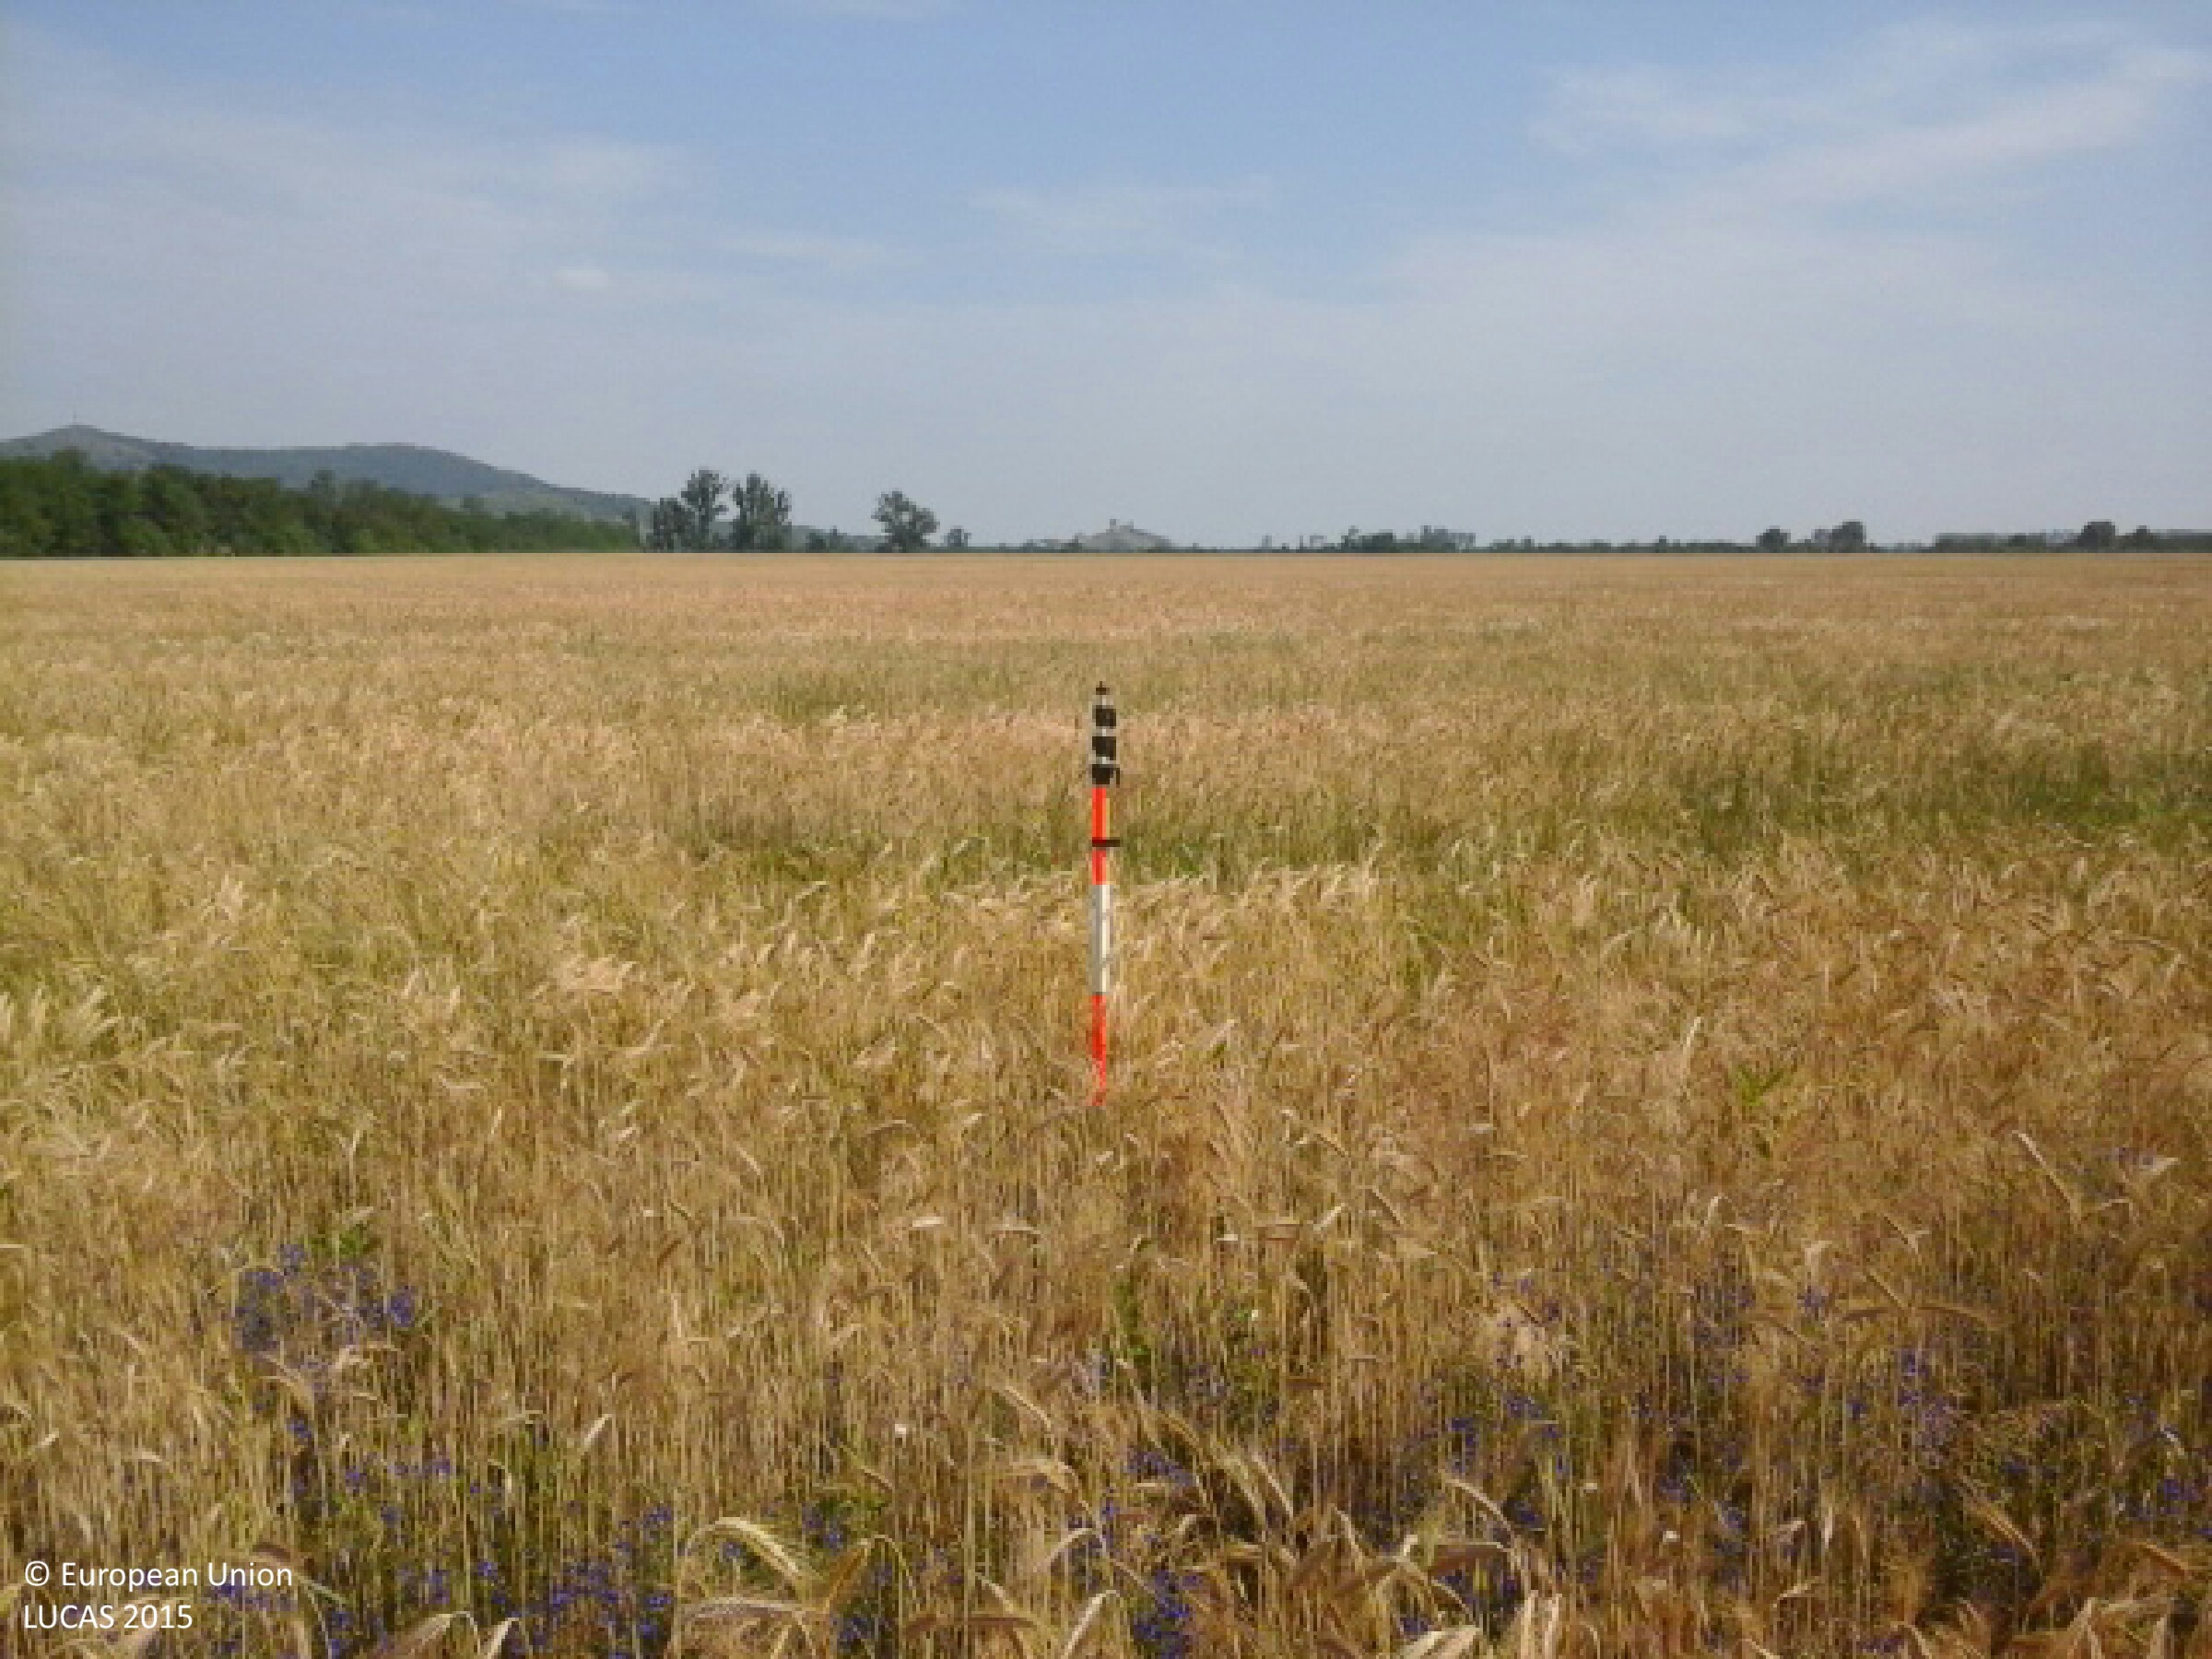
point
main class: Cropland
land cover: Barley
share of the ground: > 75 %
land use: Agriculture (excluding fallow land and kitchen gardens)
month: June
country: HU
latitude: 48.3328
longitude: 21.7998
